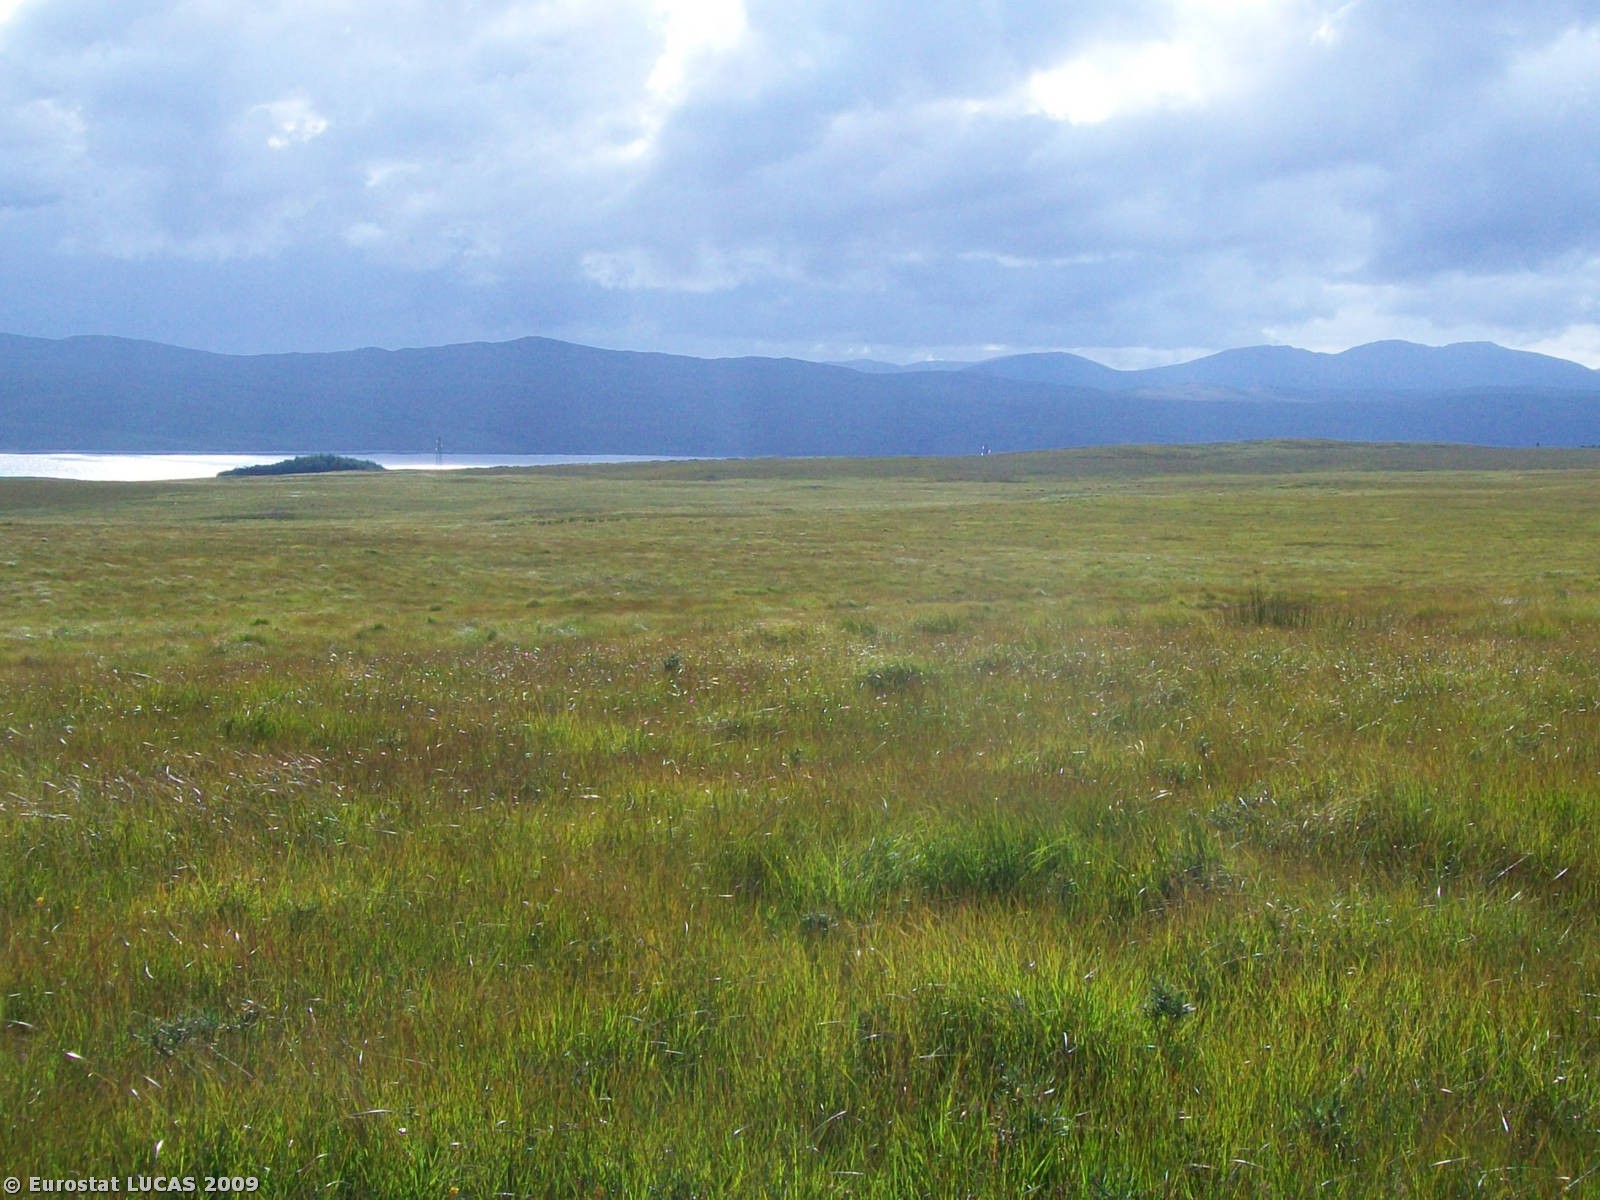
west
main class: Grassland
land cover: Grassland without tree/shrub cover
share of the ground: > 75 %
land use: Fallow land
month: August
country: GB
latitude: 58.1233
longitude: -4.5015
